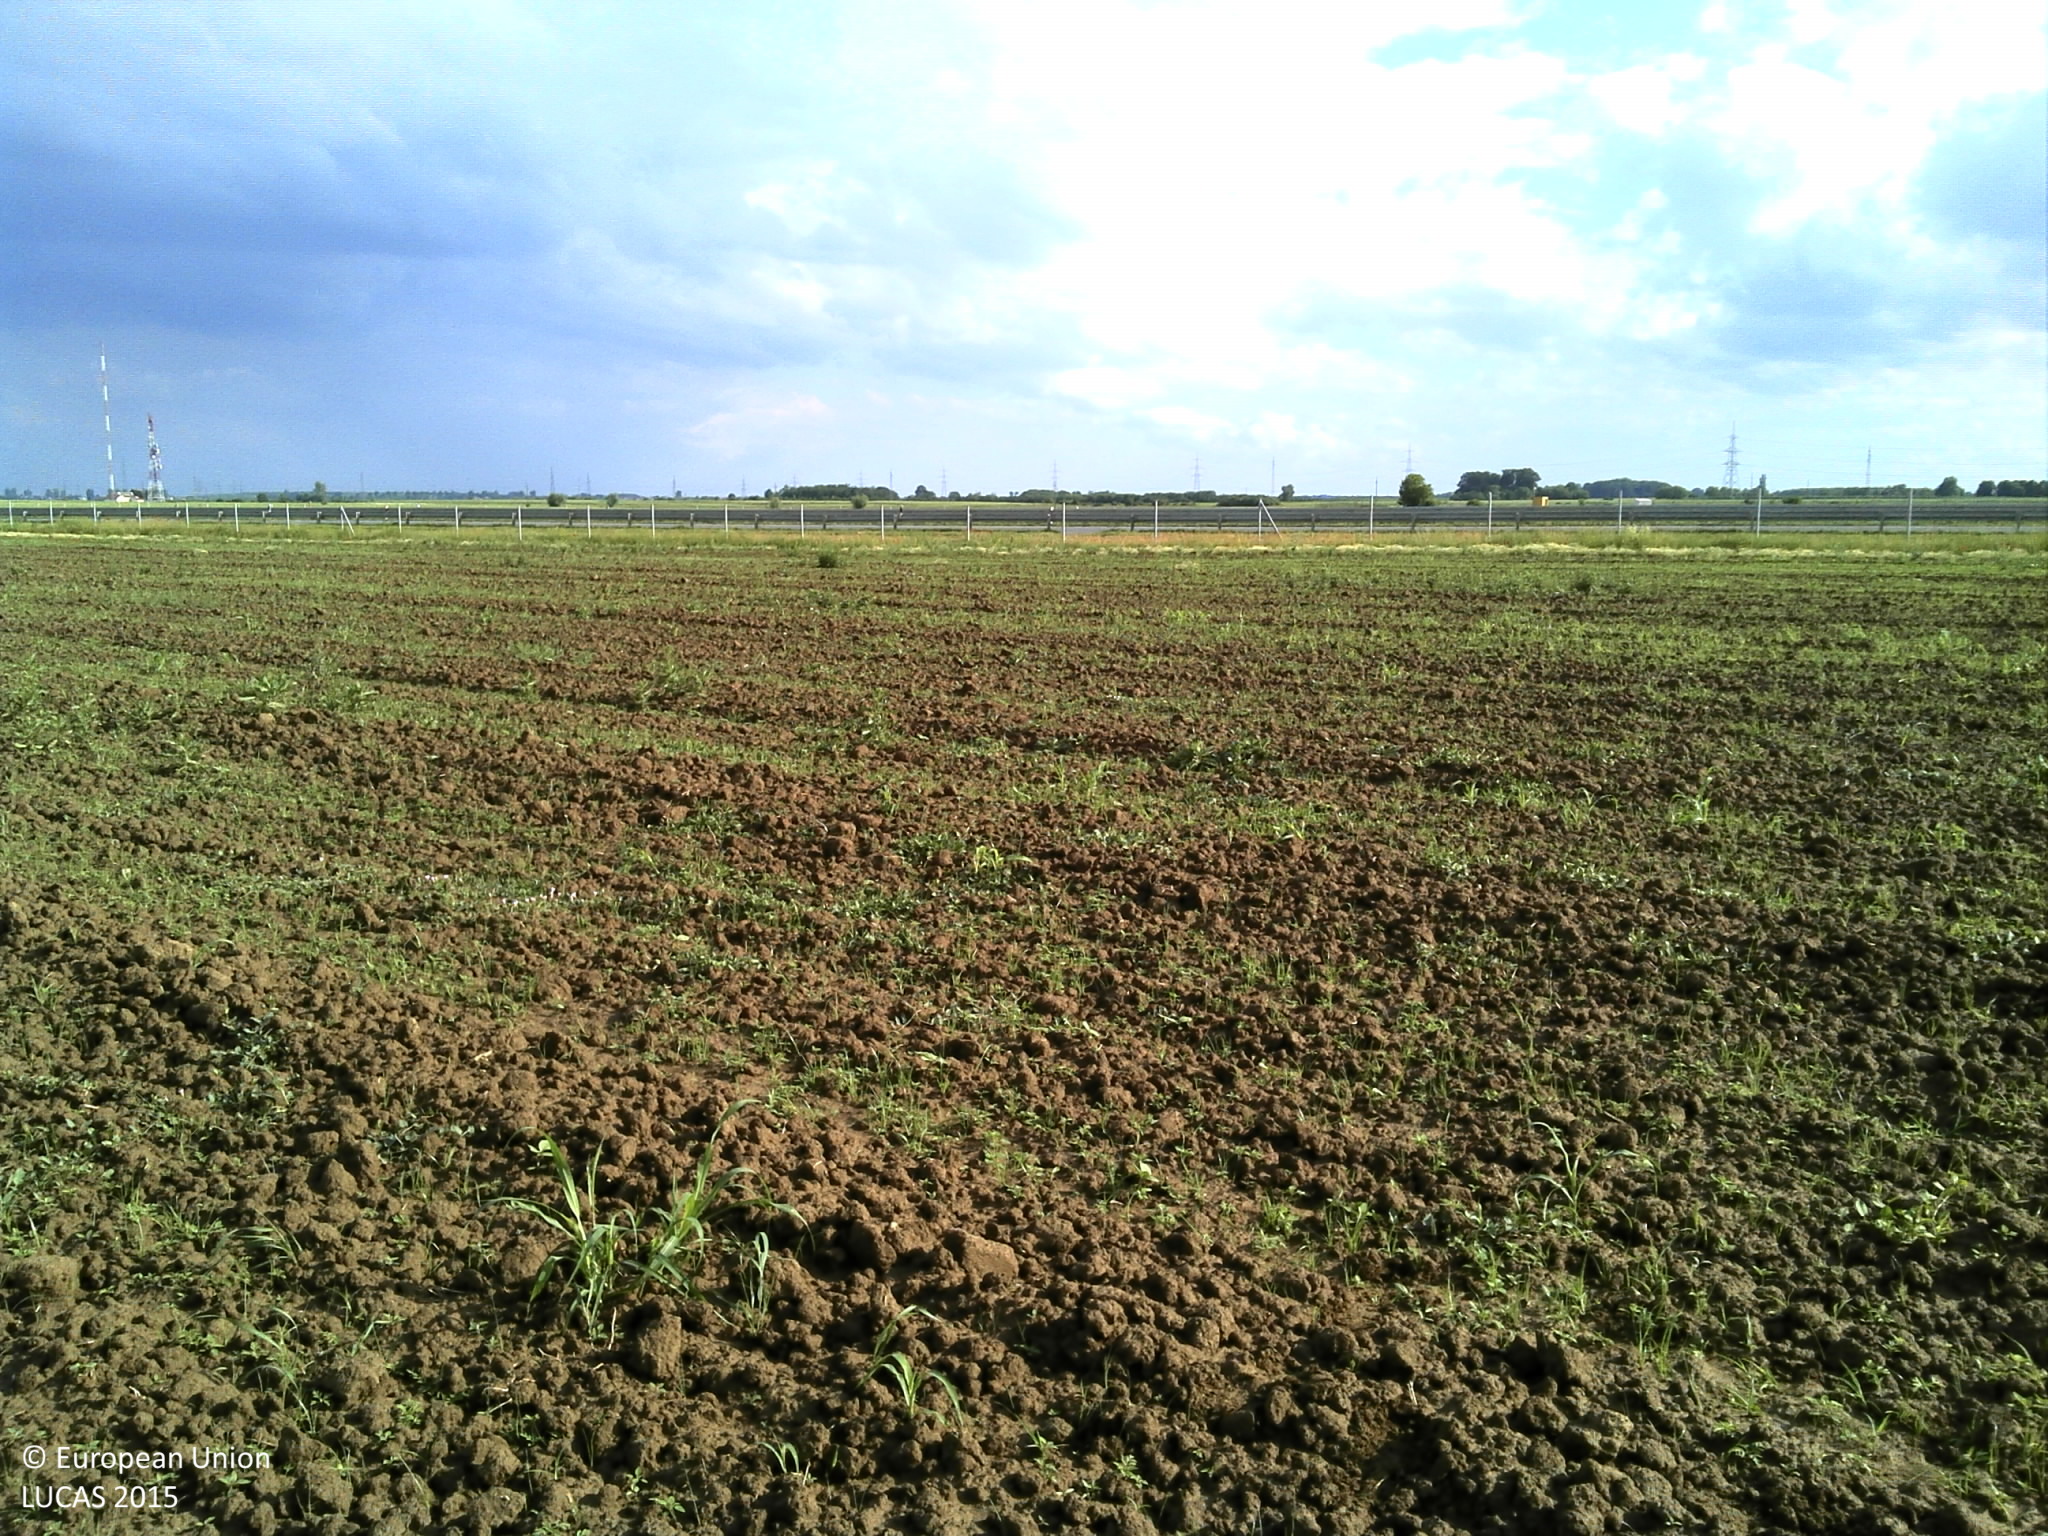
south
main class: Cropland
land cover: Sunflower
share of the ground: < 10 %
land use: Agriculture (excluding fallow land and kitchen gardens)
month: May
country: HR
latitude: 45.5713
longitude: 18.5796
